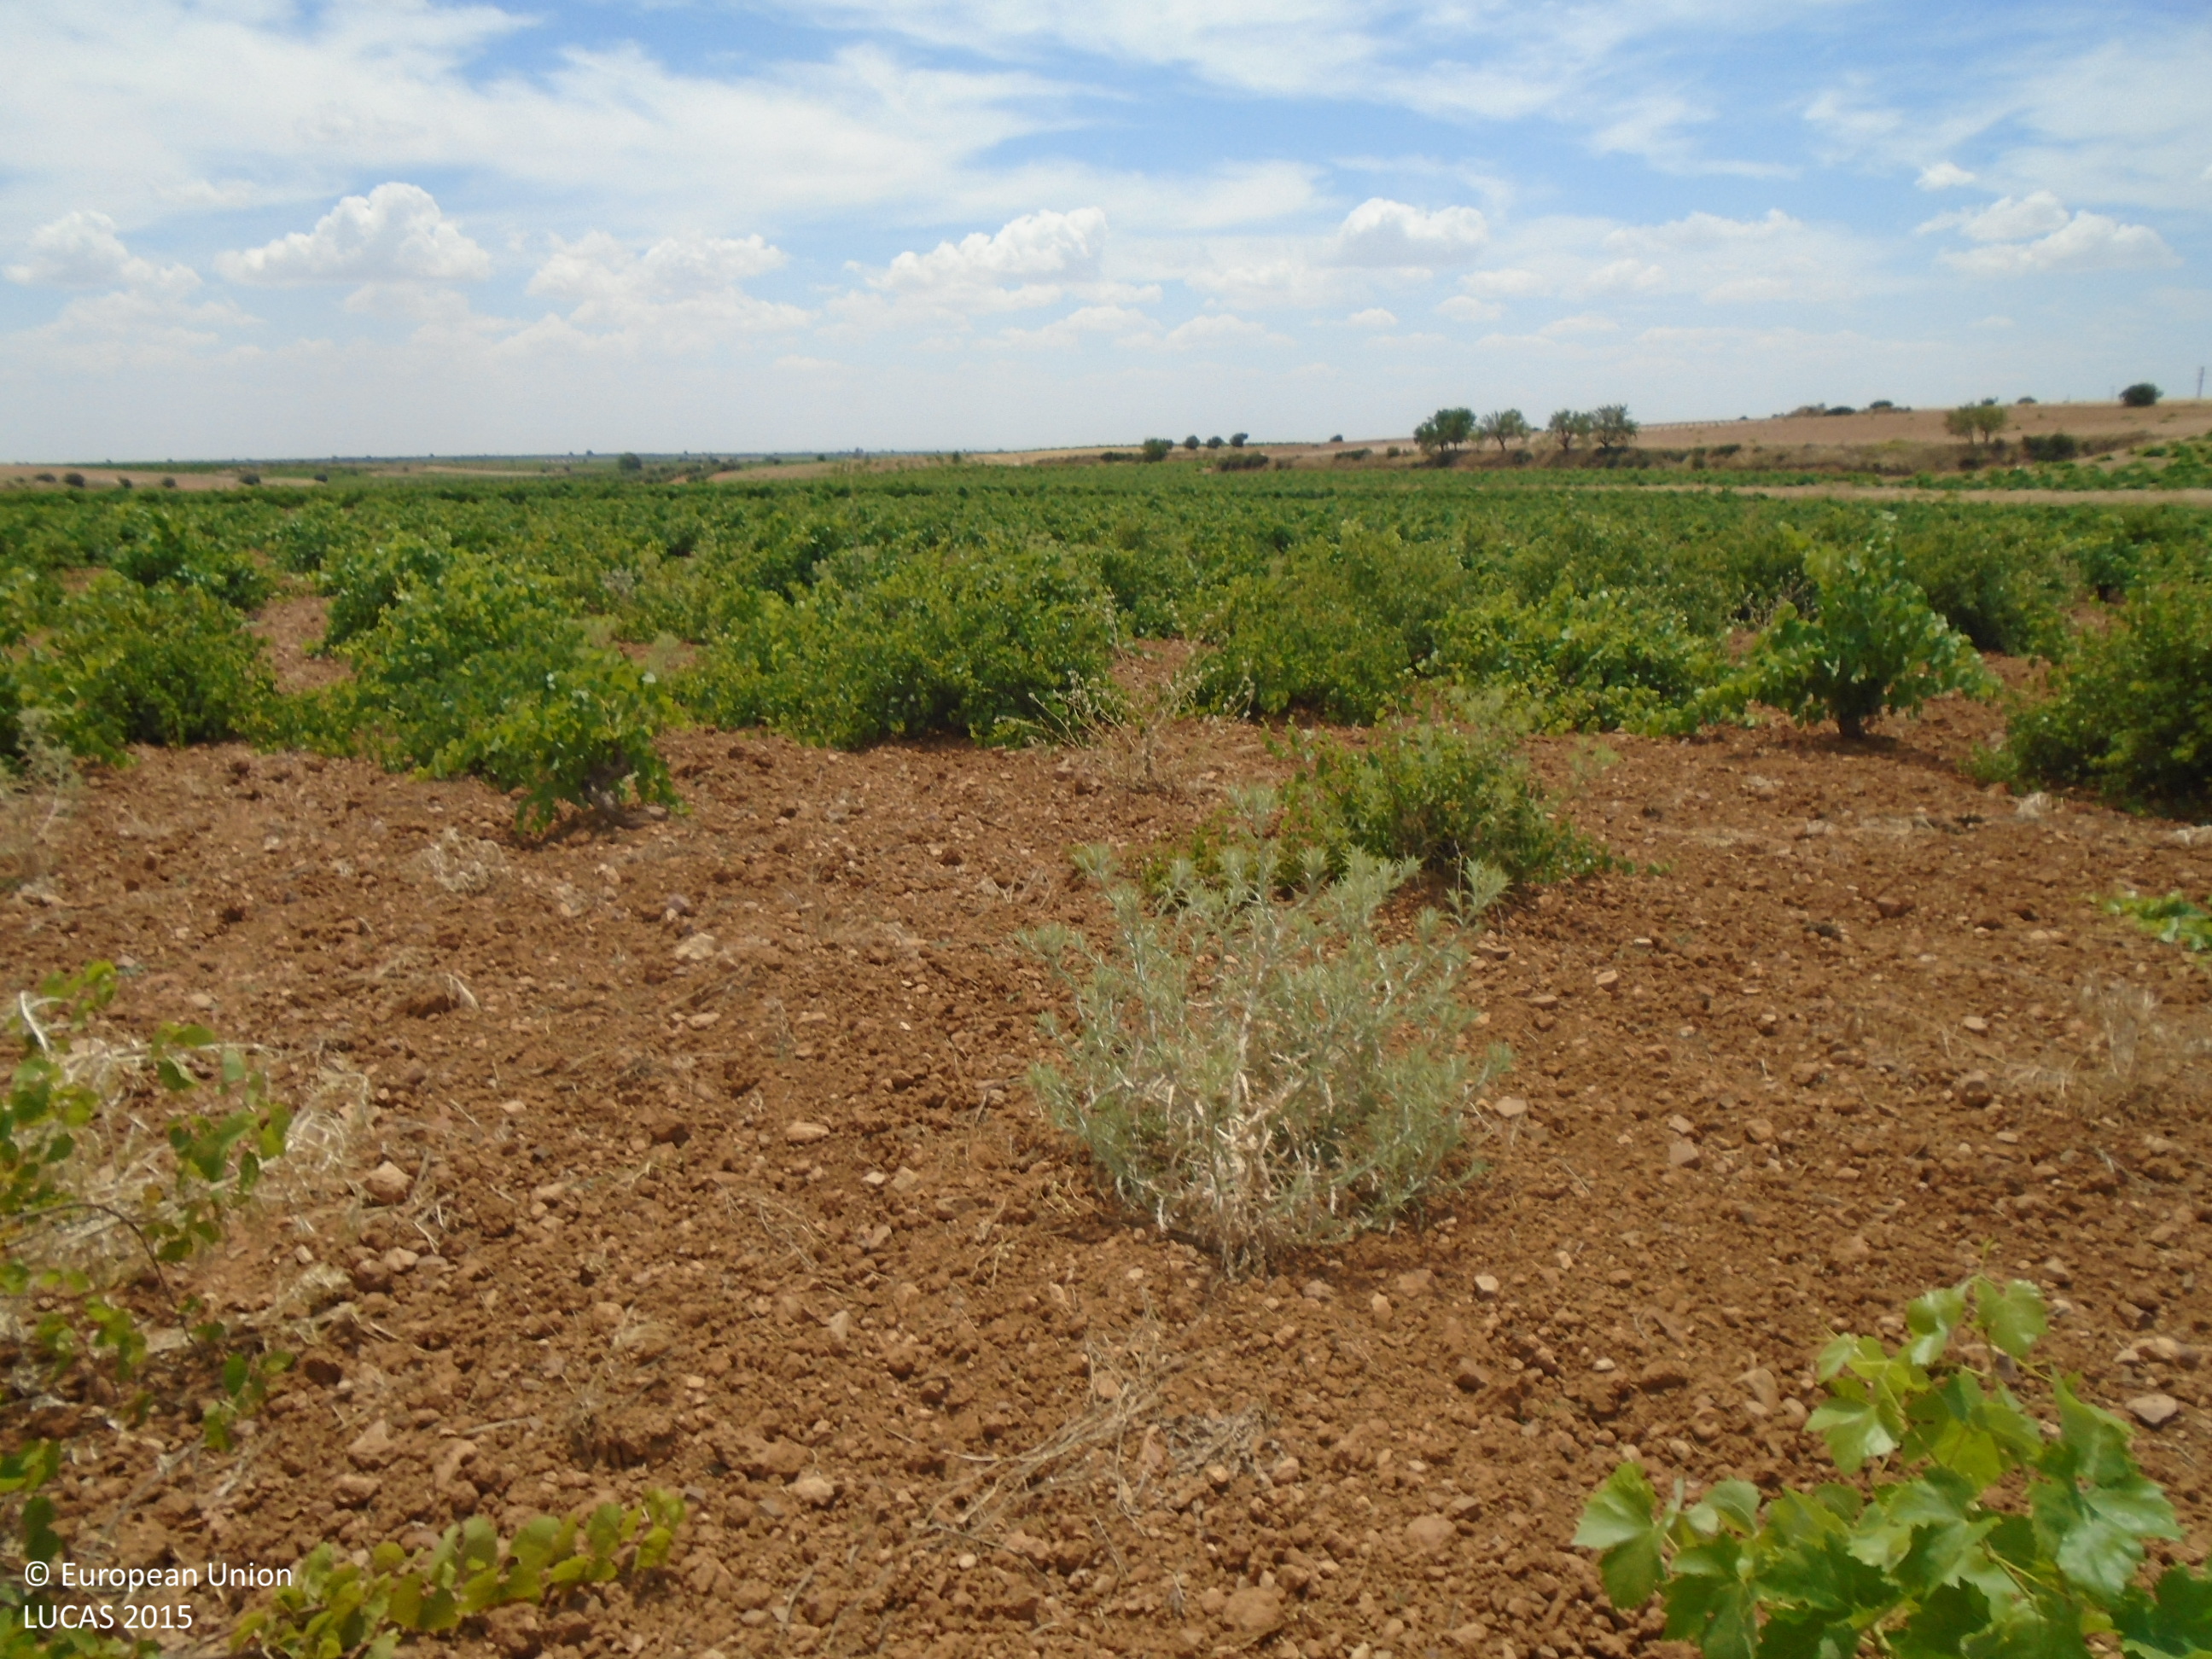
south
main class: Cropland
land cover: Vineyards
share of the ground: 25 - 50 %
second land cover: Other bare soil
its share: > 75 %
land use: Agriculture (excluding fallow land and kitchen gardens)
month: June
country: ES
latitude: 39.2261
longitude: -3.5843
